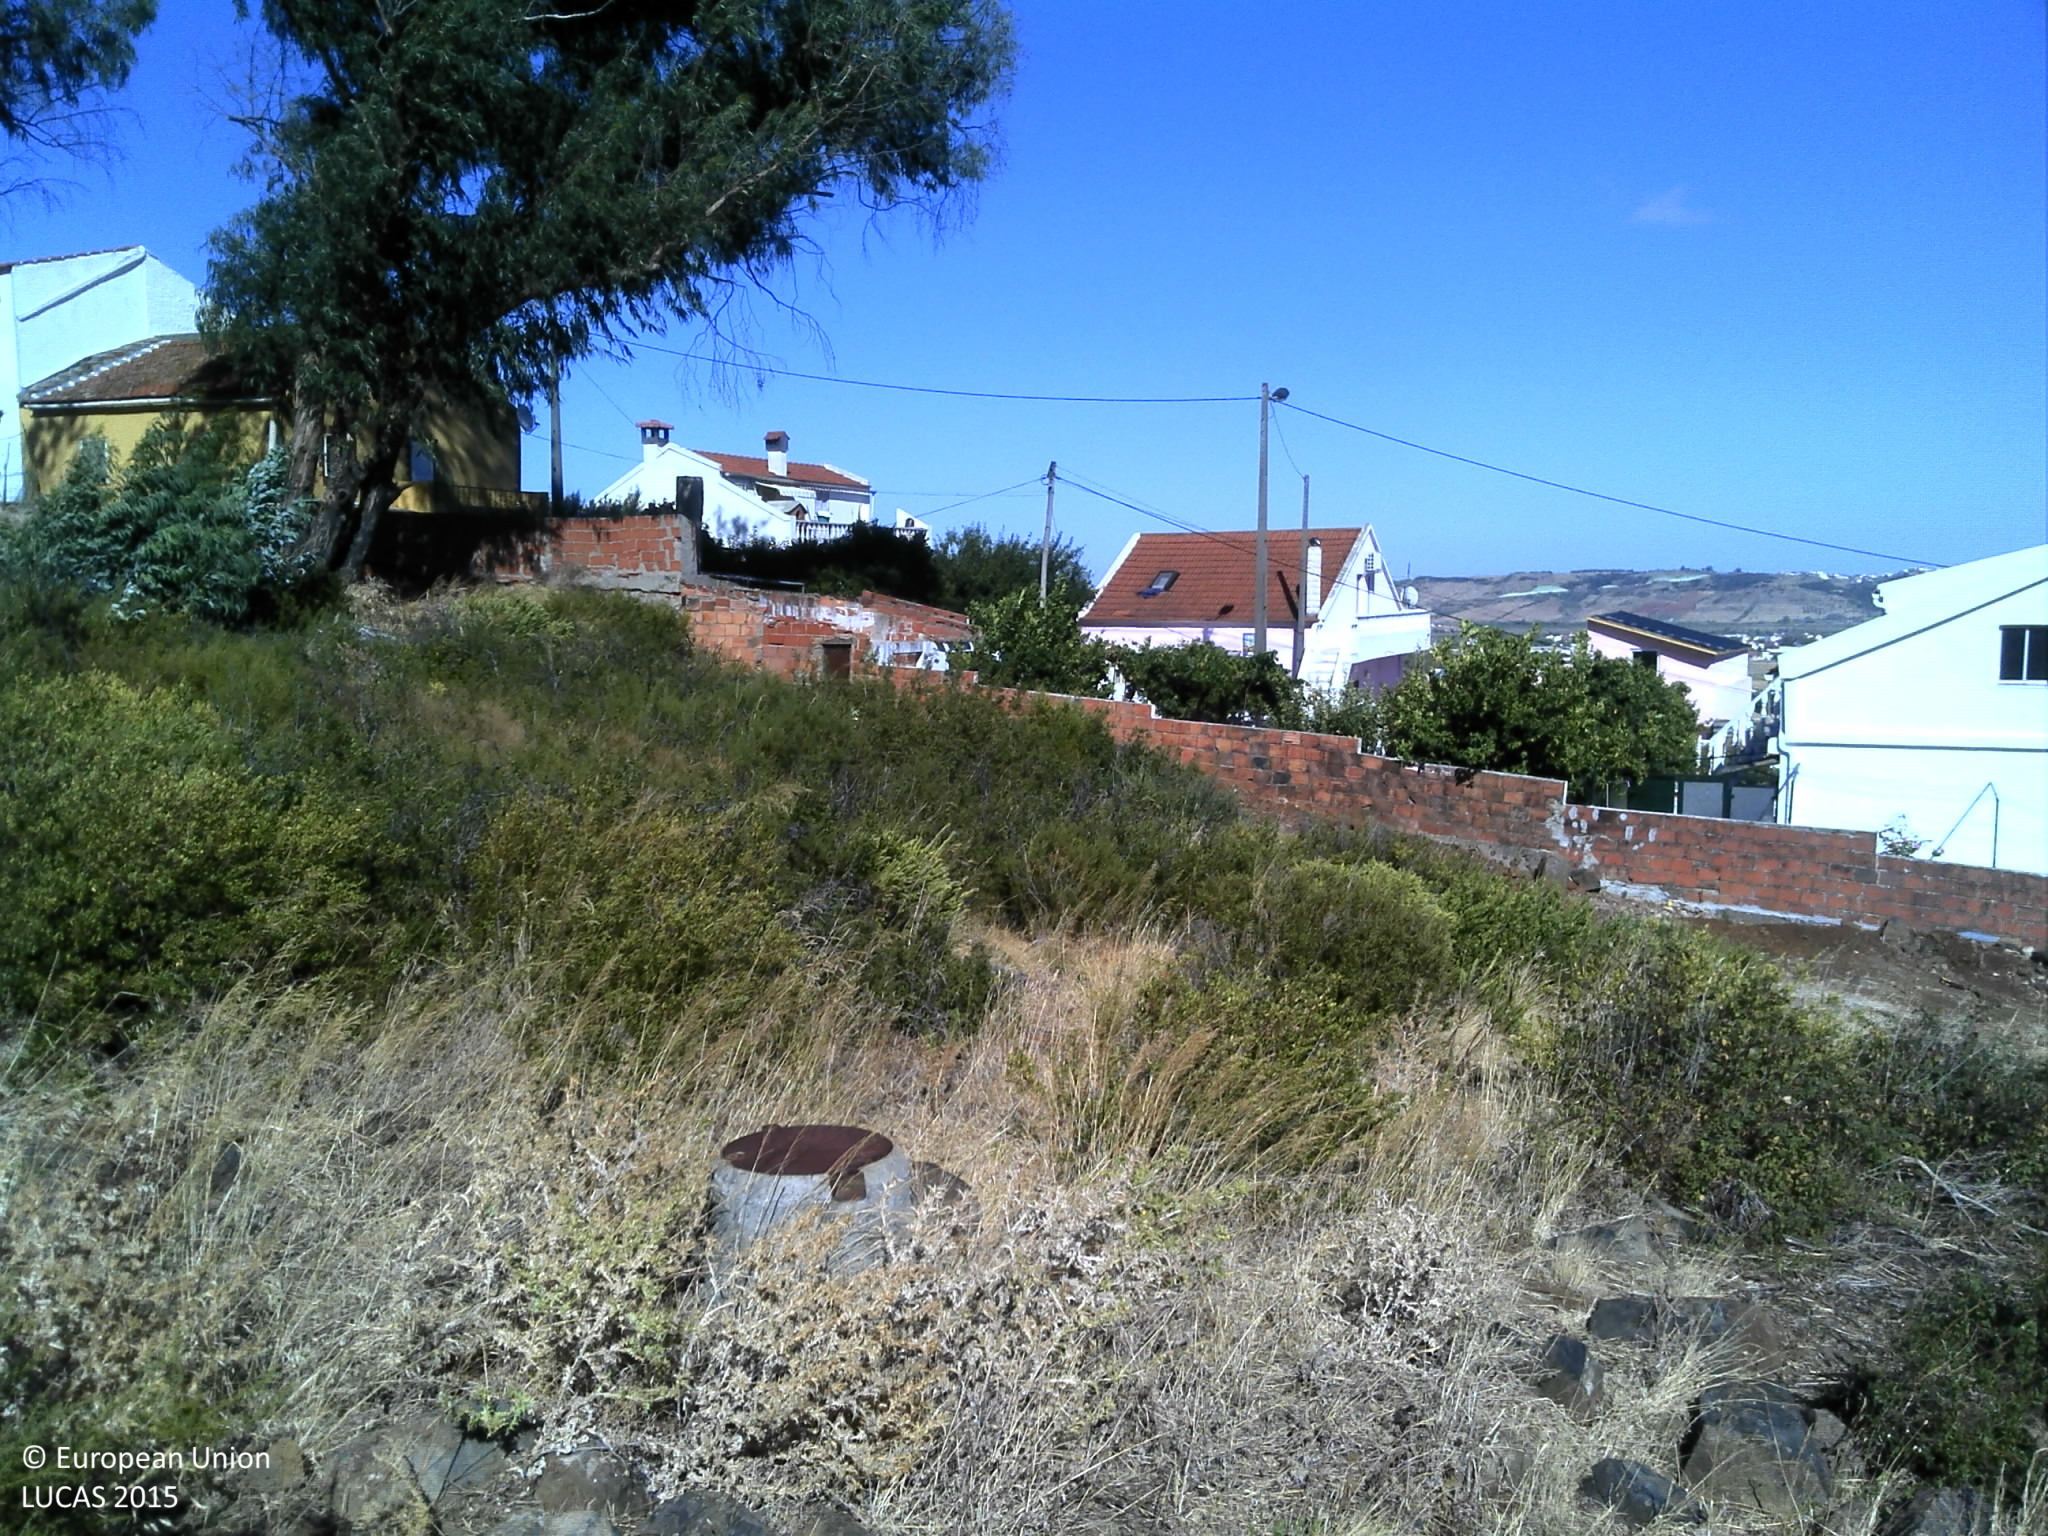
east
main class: Shrubland
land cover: Shrubland with sparse tree cover
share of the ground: 50 - 75 %
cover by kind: shrubs 65 %, unconsolidated bare surface 30 %, broadleaved forest trees 5 %
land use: Semi-natural and natural areas not in use
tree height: > 5 m
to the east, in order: Shrubland with sparse tree cover; Rivers and streams; Shrubland with sparse tree cover; Rock outcrops; Shrubland with sparse tree cover; Artificial constructions in urban areas; Shrubland with sparse tree cover; Grassland without tree/shrub cover
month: August
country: PT
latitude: 38.8566
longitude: -9.1733
